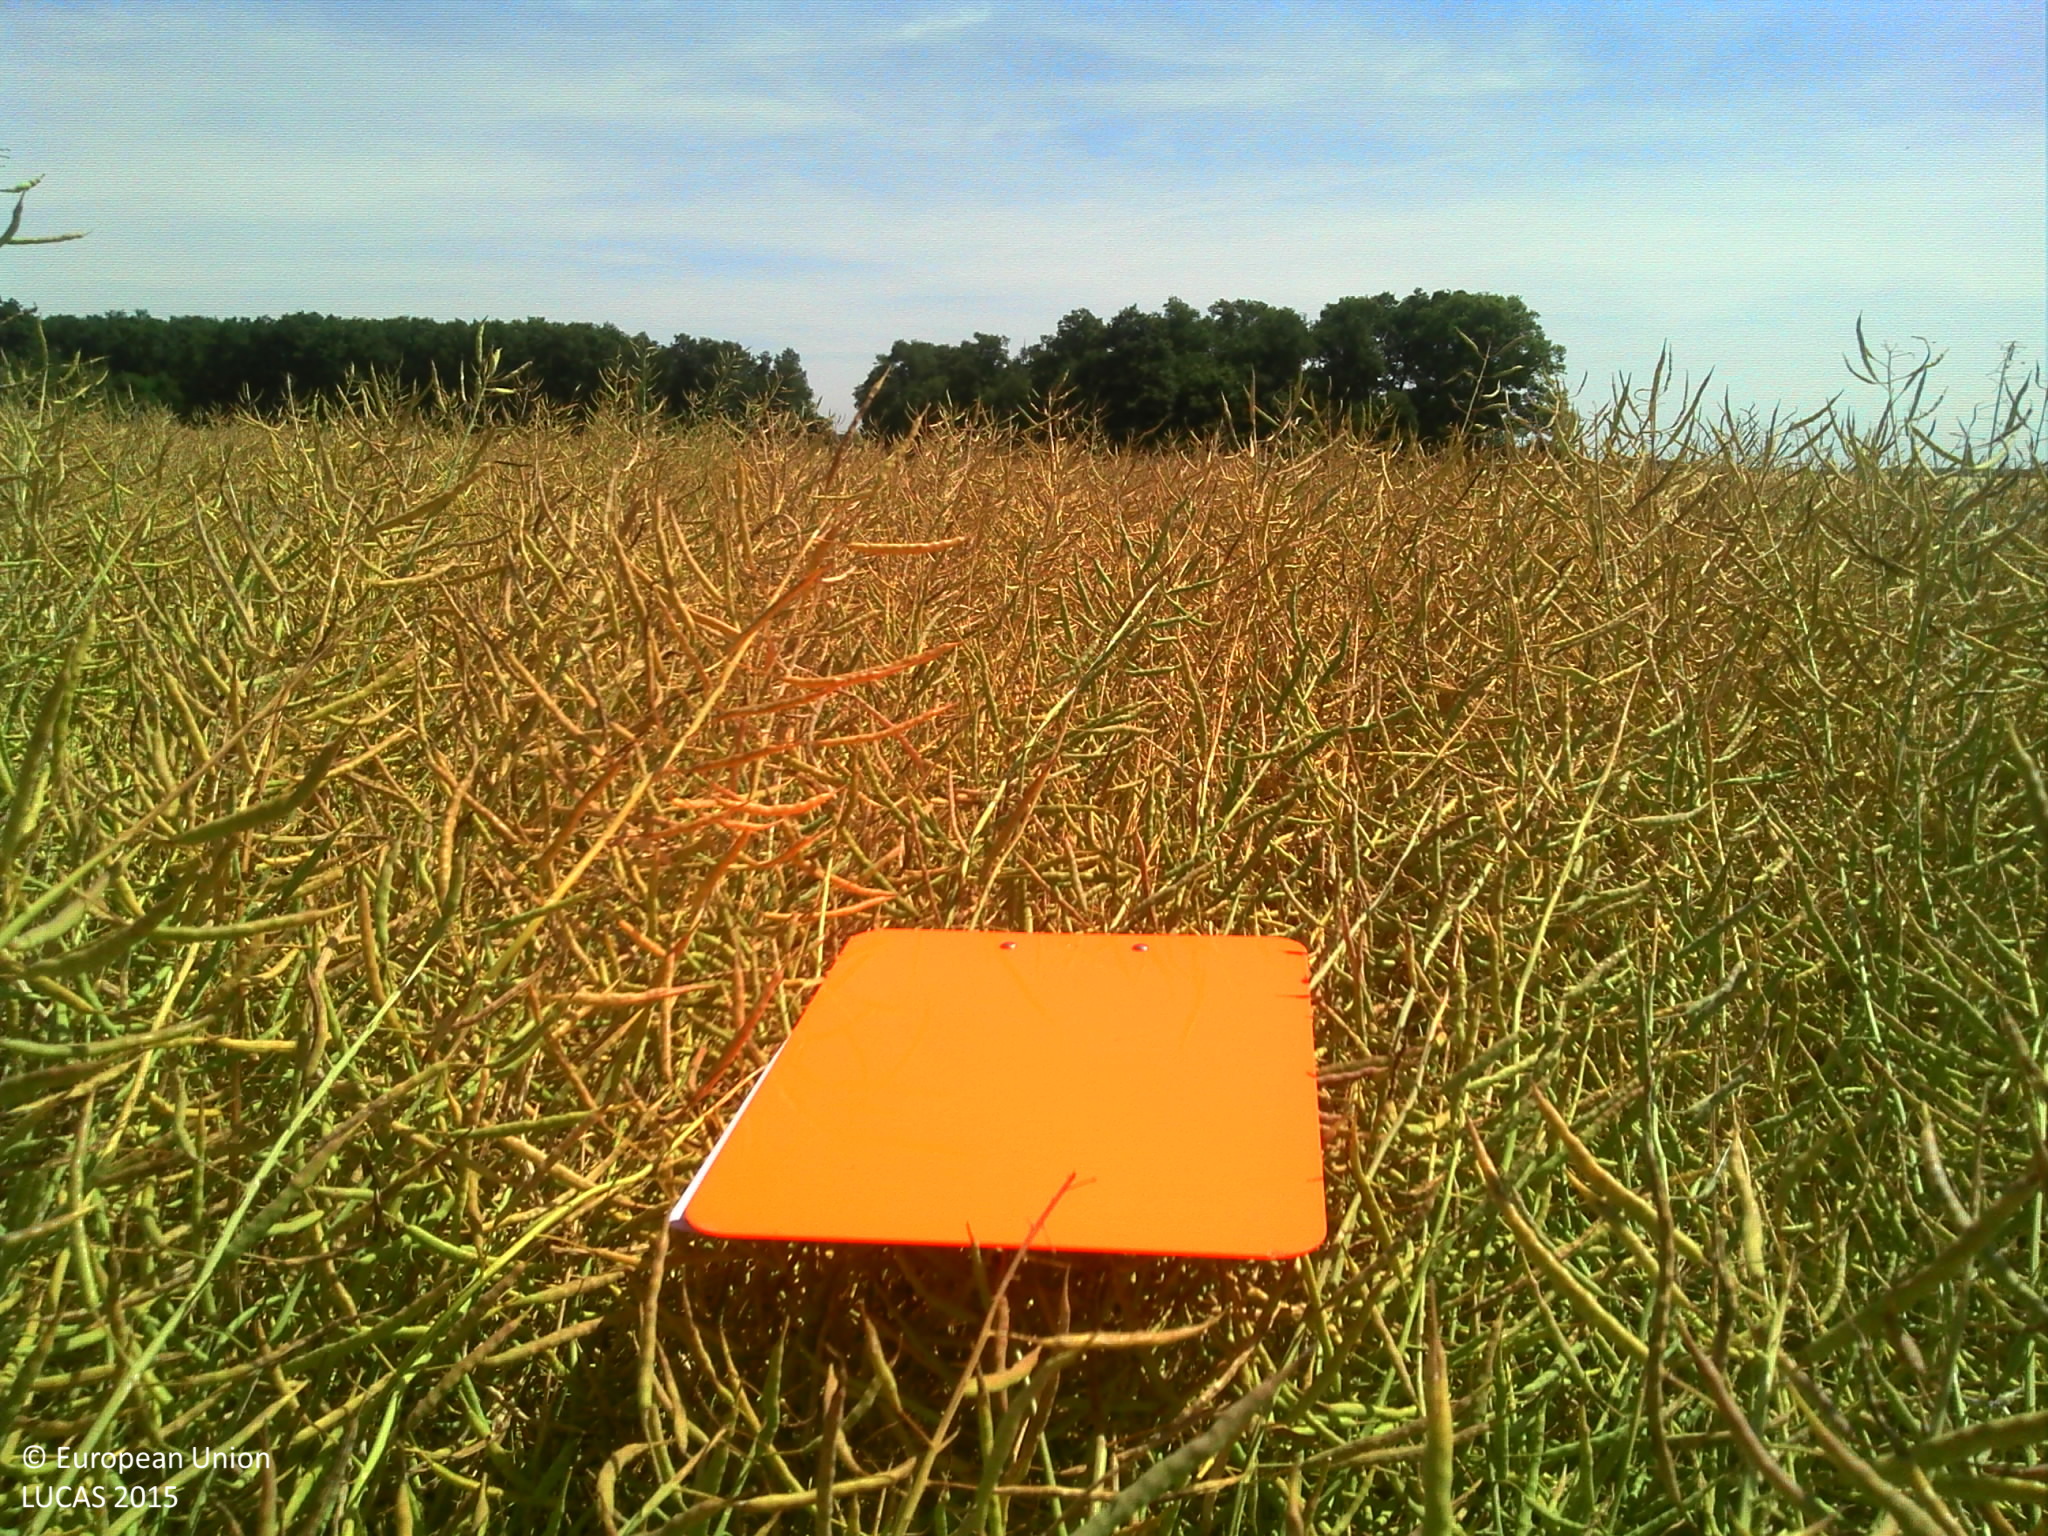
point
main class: Cropland
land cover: Rape and turnip rape
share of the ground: > 75 %
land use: Agriculture (excluding fallow land and kitchen gardens)
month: June
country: FR
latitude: 48.6313
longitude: 1.2017
